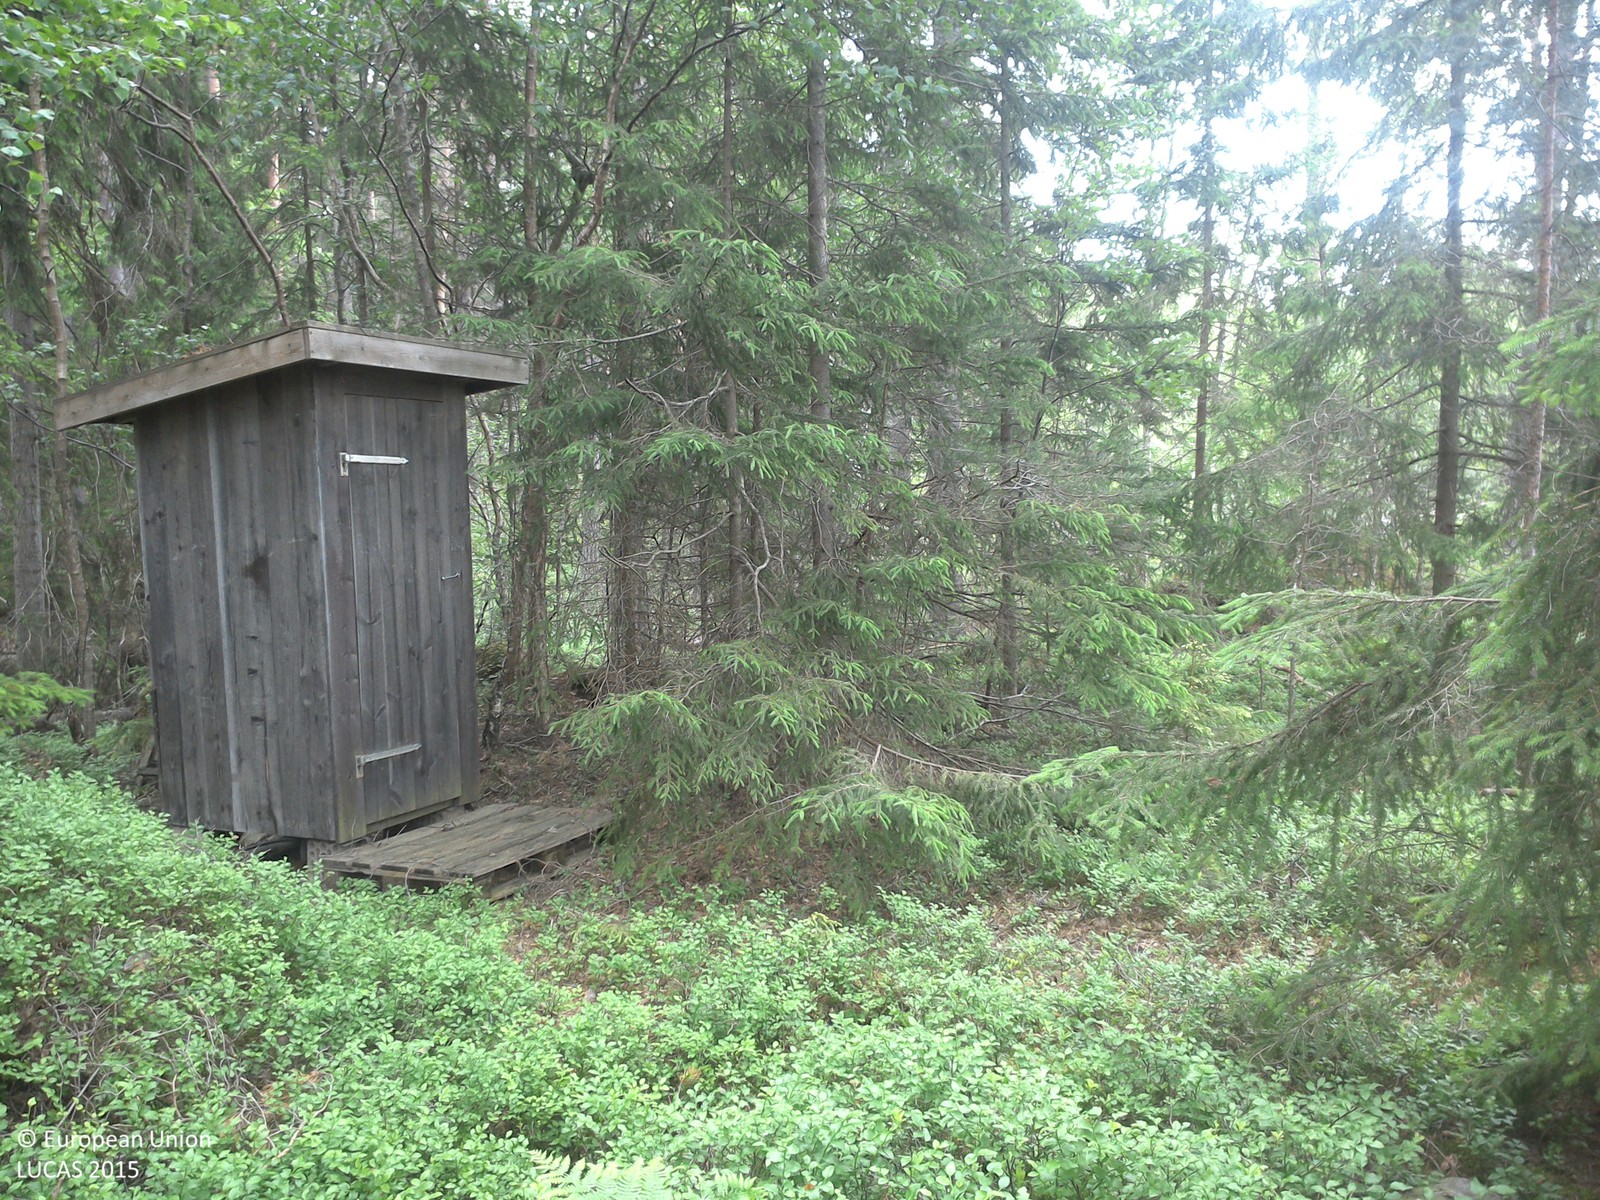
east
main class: Woodland
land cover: Pine dominated coniferous woodland
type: boreal forest
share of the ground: 50 - 75 %
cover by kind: coniferous forest trees 70 %, herbaceous plants 15 %, lichens and mosses 10 %, broadleaved forest trees 5 %
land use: Forestry
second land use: Amenities, museums, leisure
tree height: > 5 m
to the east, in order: Pine dominated coniferous woodland; Spruce dominated coniferous woodland; Pine dominated coniferous woodland
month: June
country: SE
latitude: 58.1080
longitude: 15.4766
